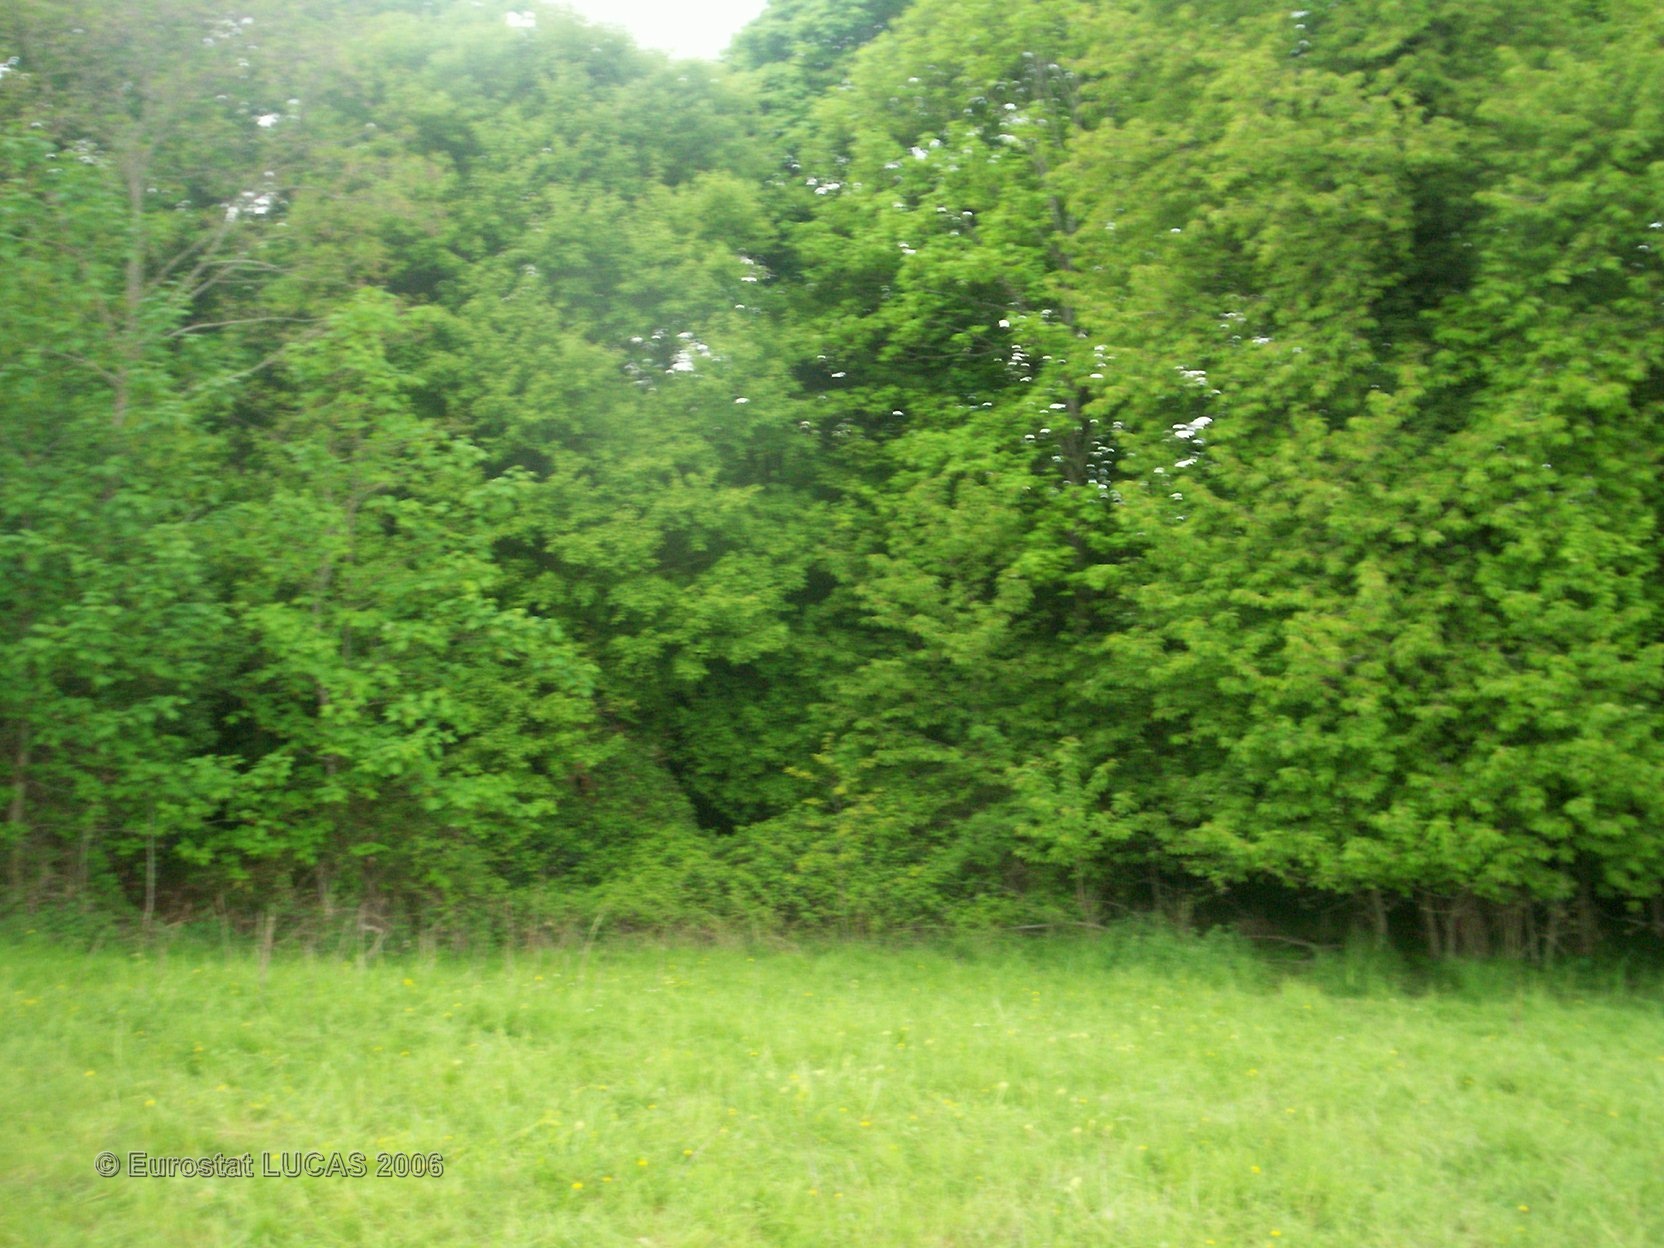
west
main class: Grassland
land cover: Grassland without tree/shrub cover
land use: Agriculture (excluding fallow land and kitchen gardens)
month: May
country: FR
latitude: 45.6588
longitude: 3.1084
